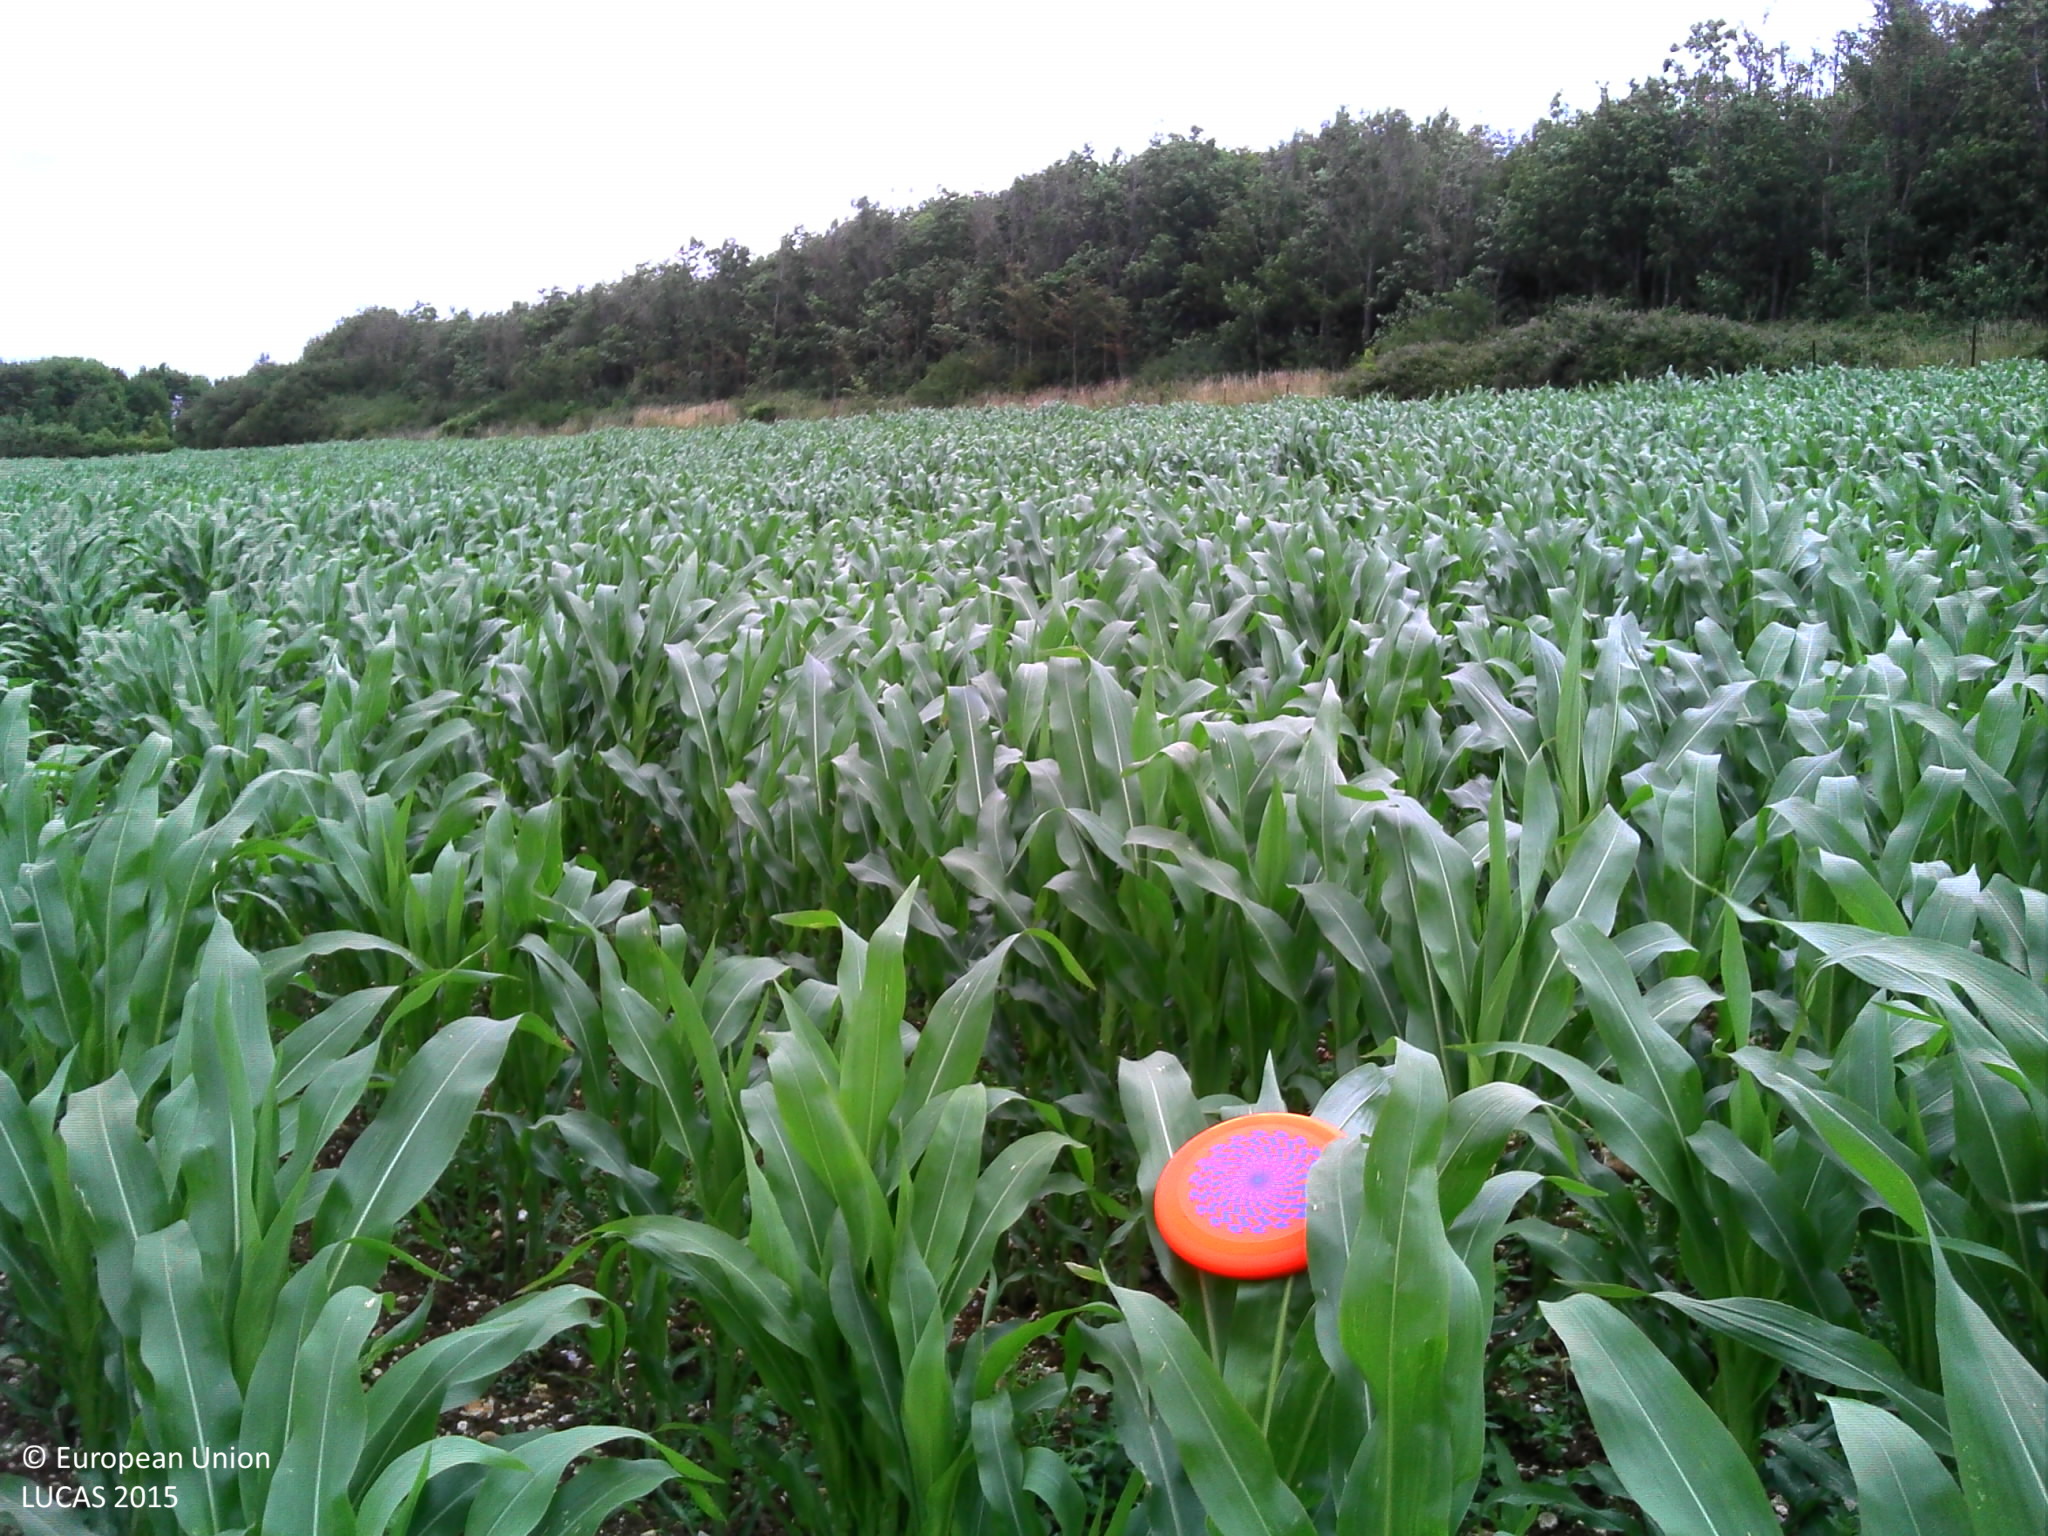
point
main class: Cropland
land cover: Maize
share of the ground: > 75 %
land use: Agriculture (excluding fallow land and kitchen gardens)
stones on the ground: 25 - 50 %
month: July
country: FR
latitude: 50.7921
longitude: 2.0544
